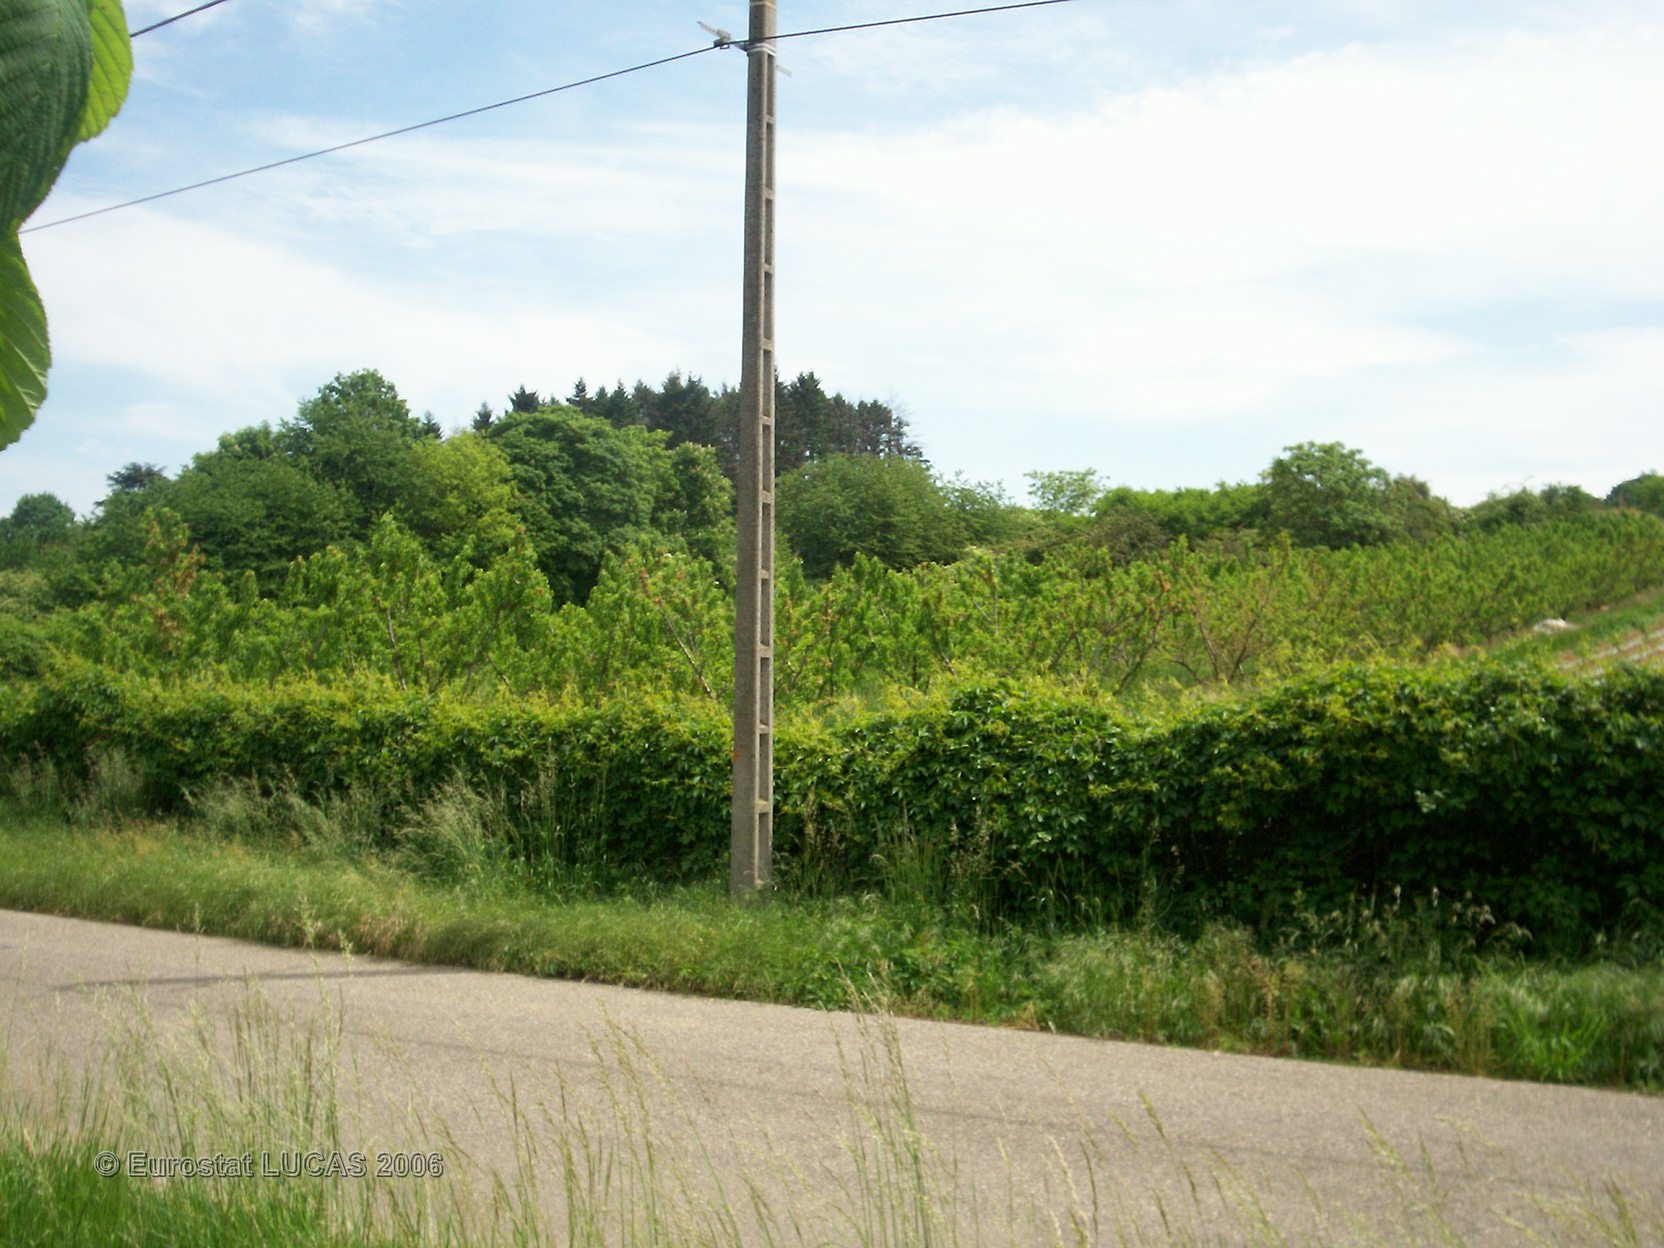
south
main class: Grassland
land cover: Grassland with sparse tree/shrub cover
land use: Unused
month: May
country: FR
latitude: 45.6834
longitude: 4.8038
